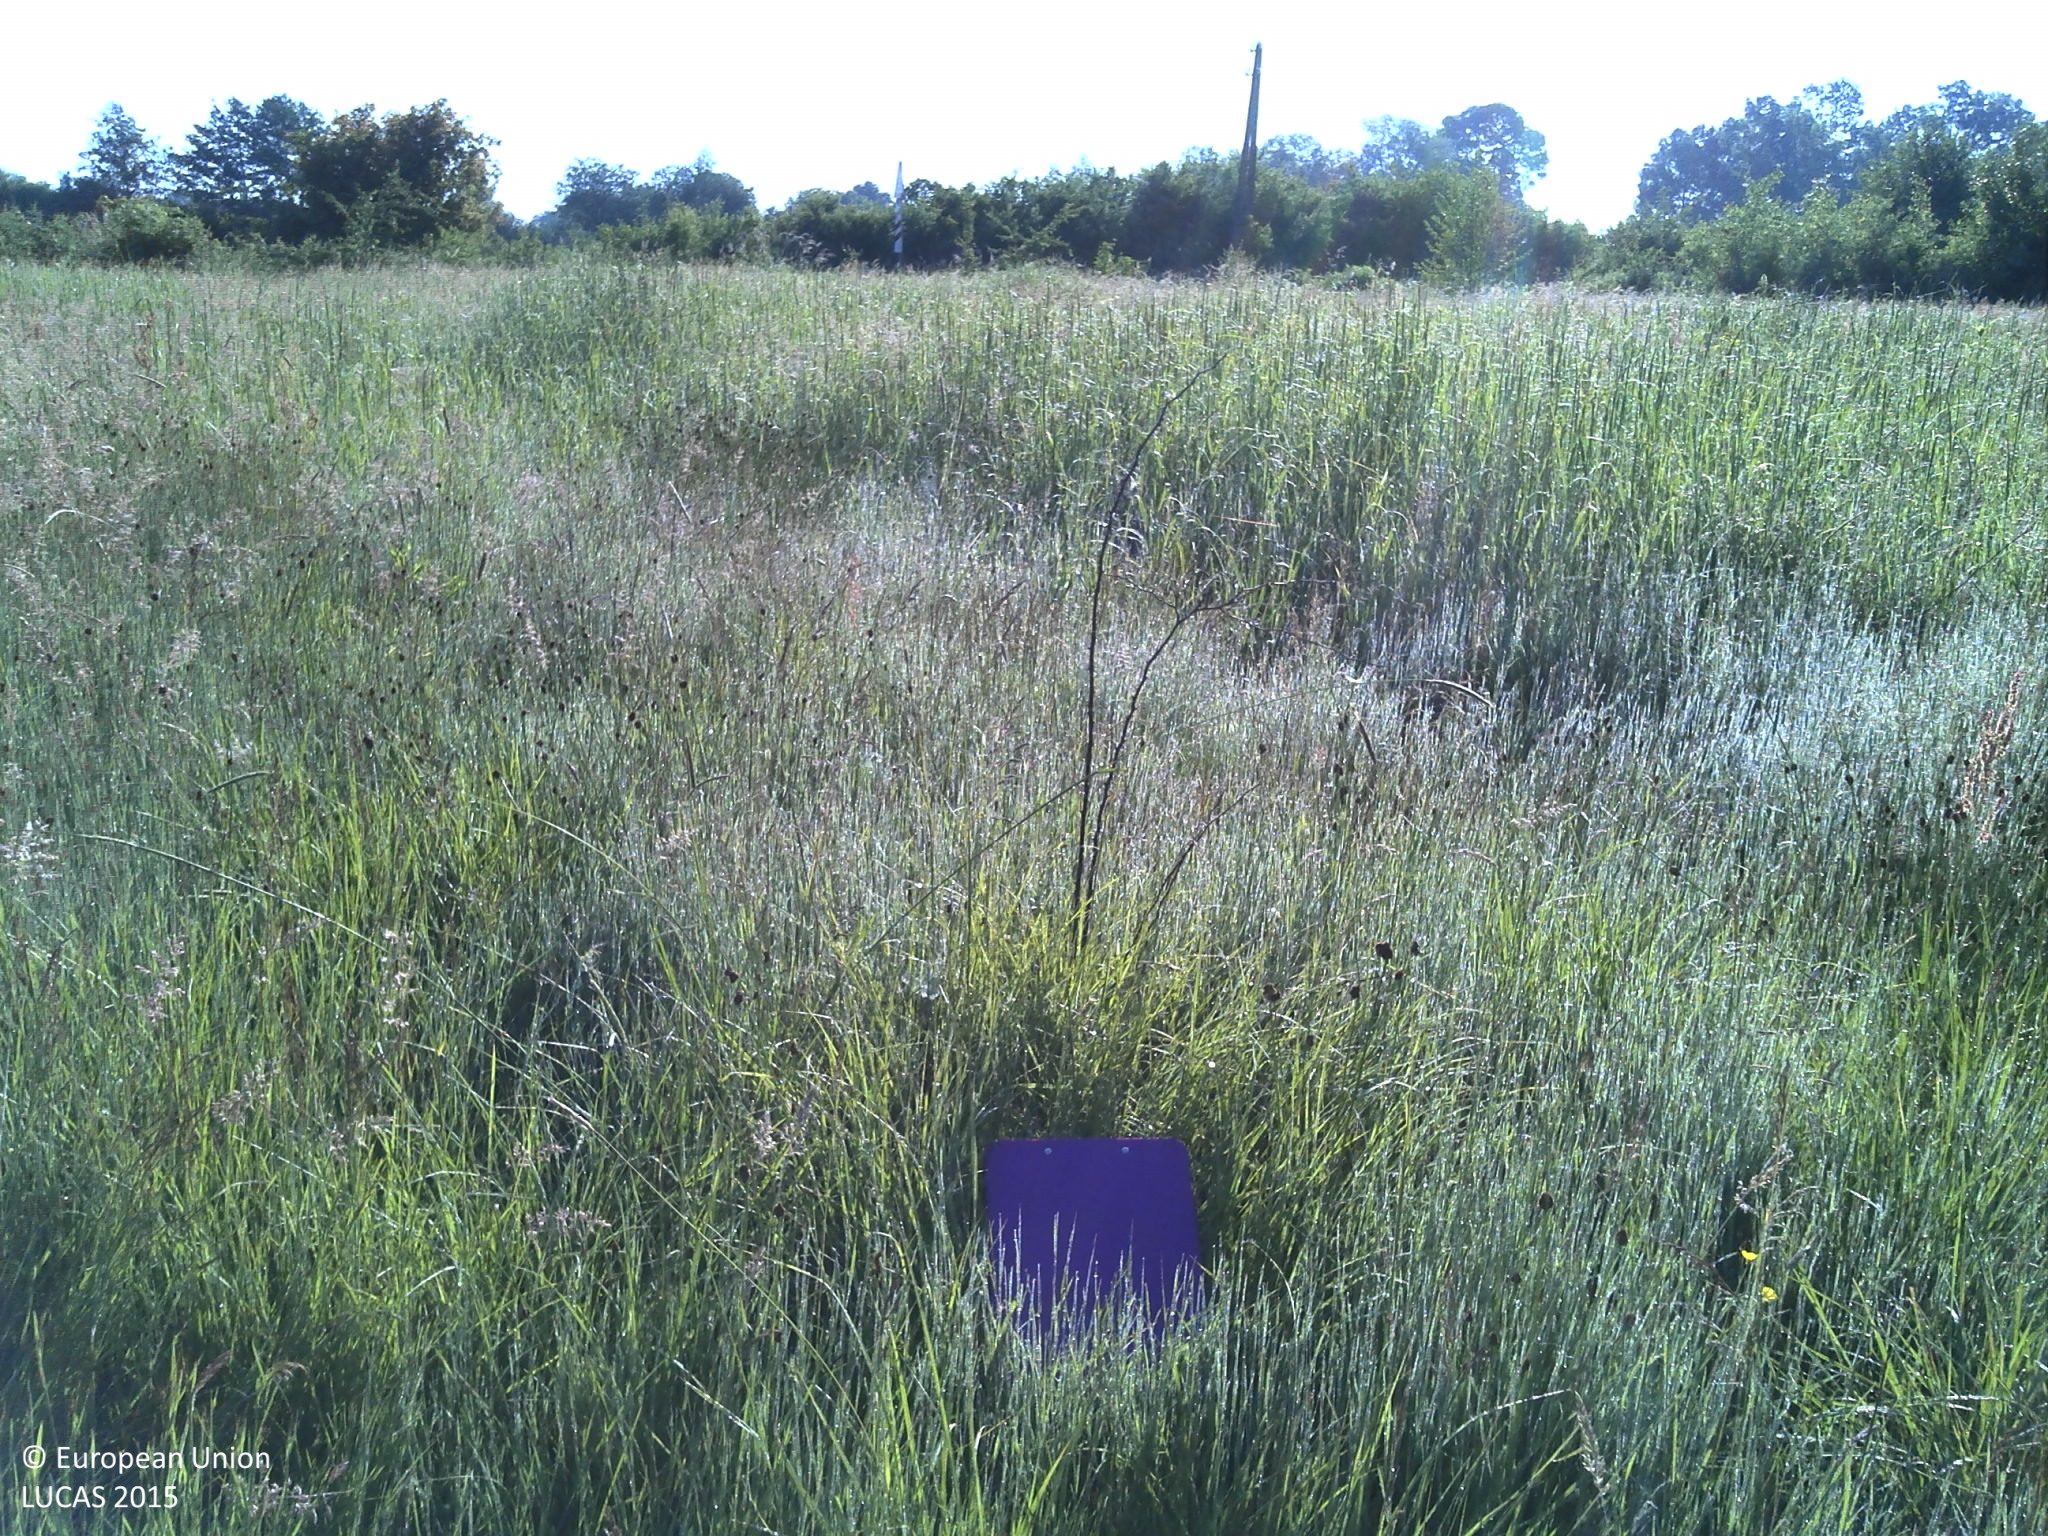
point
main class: Grassland
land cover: Spontaneously vegetated surfaces
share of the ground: > 75 %
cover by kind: herbaceous plants 100 %
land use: Abandoned areas
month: May
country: HR
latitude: 45.5477
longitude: 17.9578
